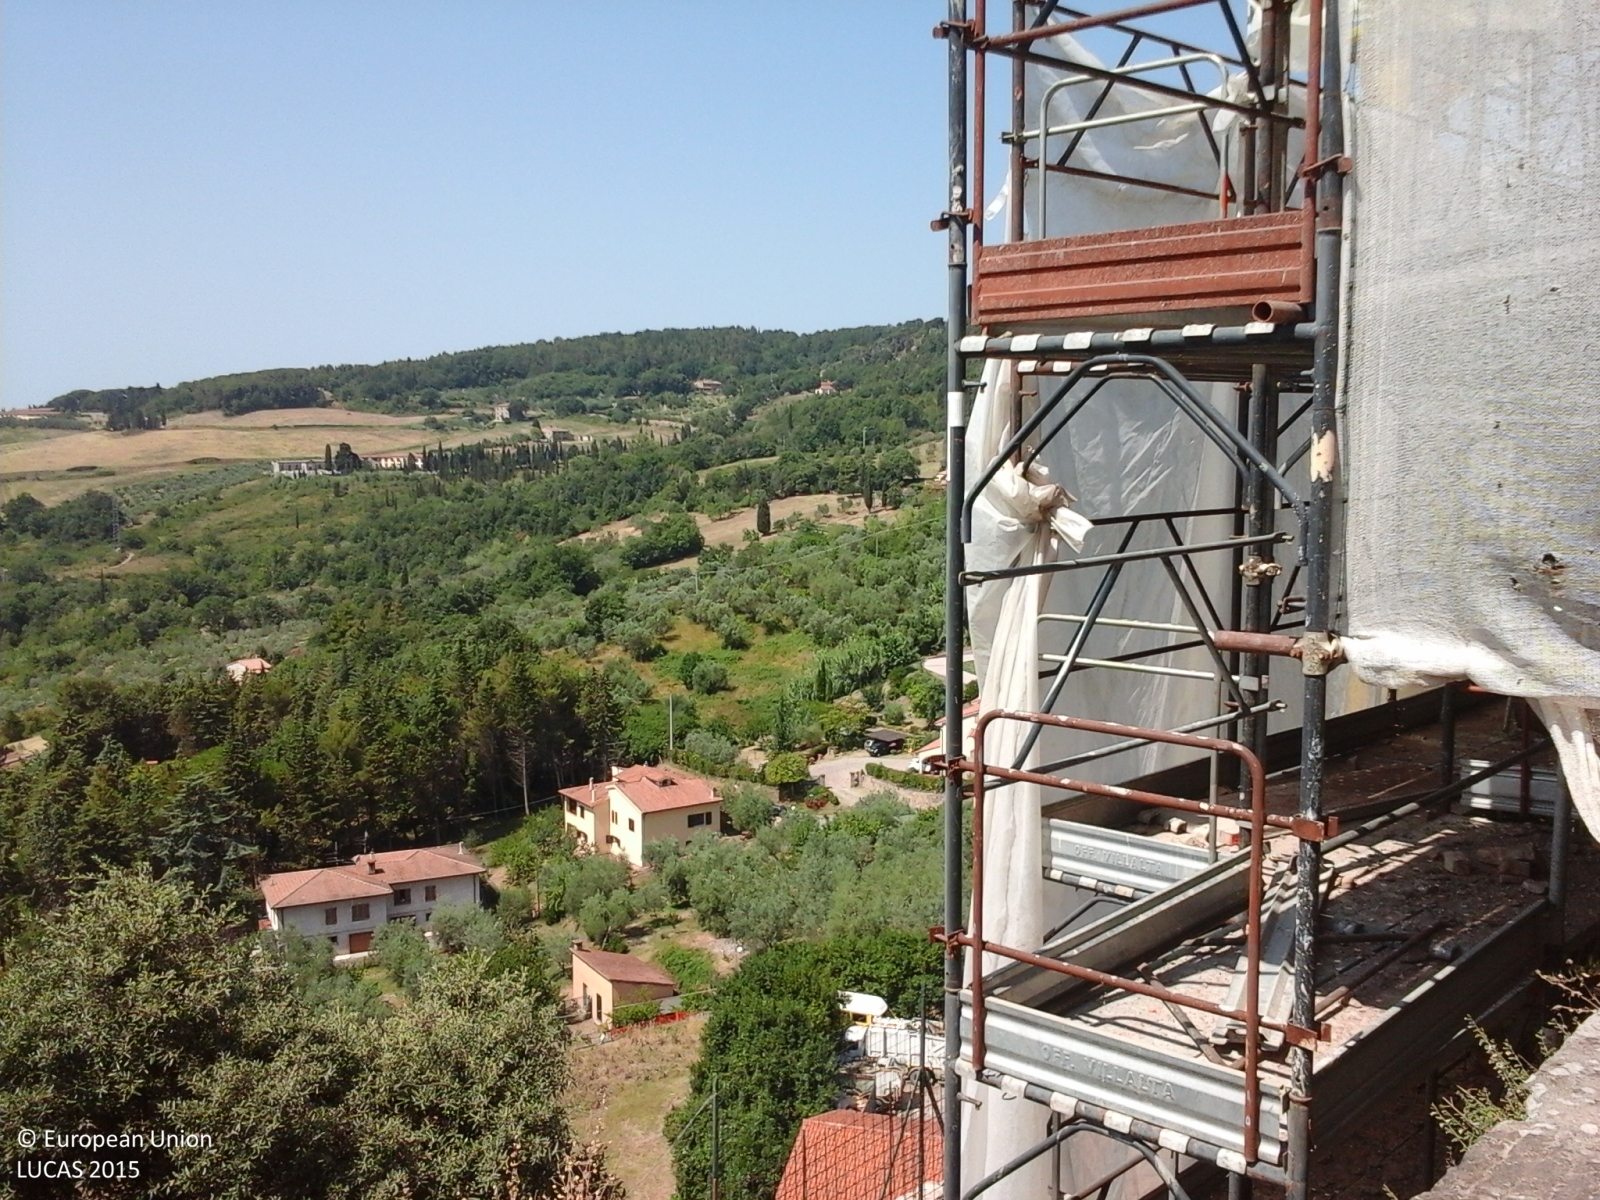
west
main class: Shrubland
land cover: Shrubland with sparse tree cover
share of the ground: 50 - 75 %
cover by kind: shrubs 95 %, coniferous forest trees 5 %
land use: Semi-natural and natural areas not in use
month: July
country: IT
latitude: 43.3915
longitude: 10.7509
